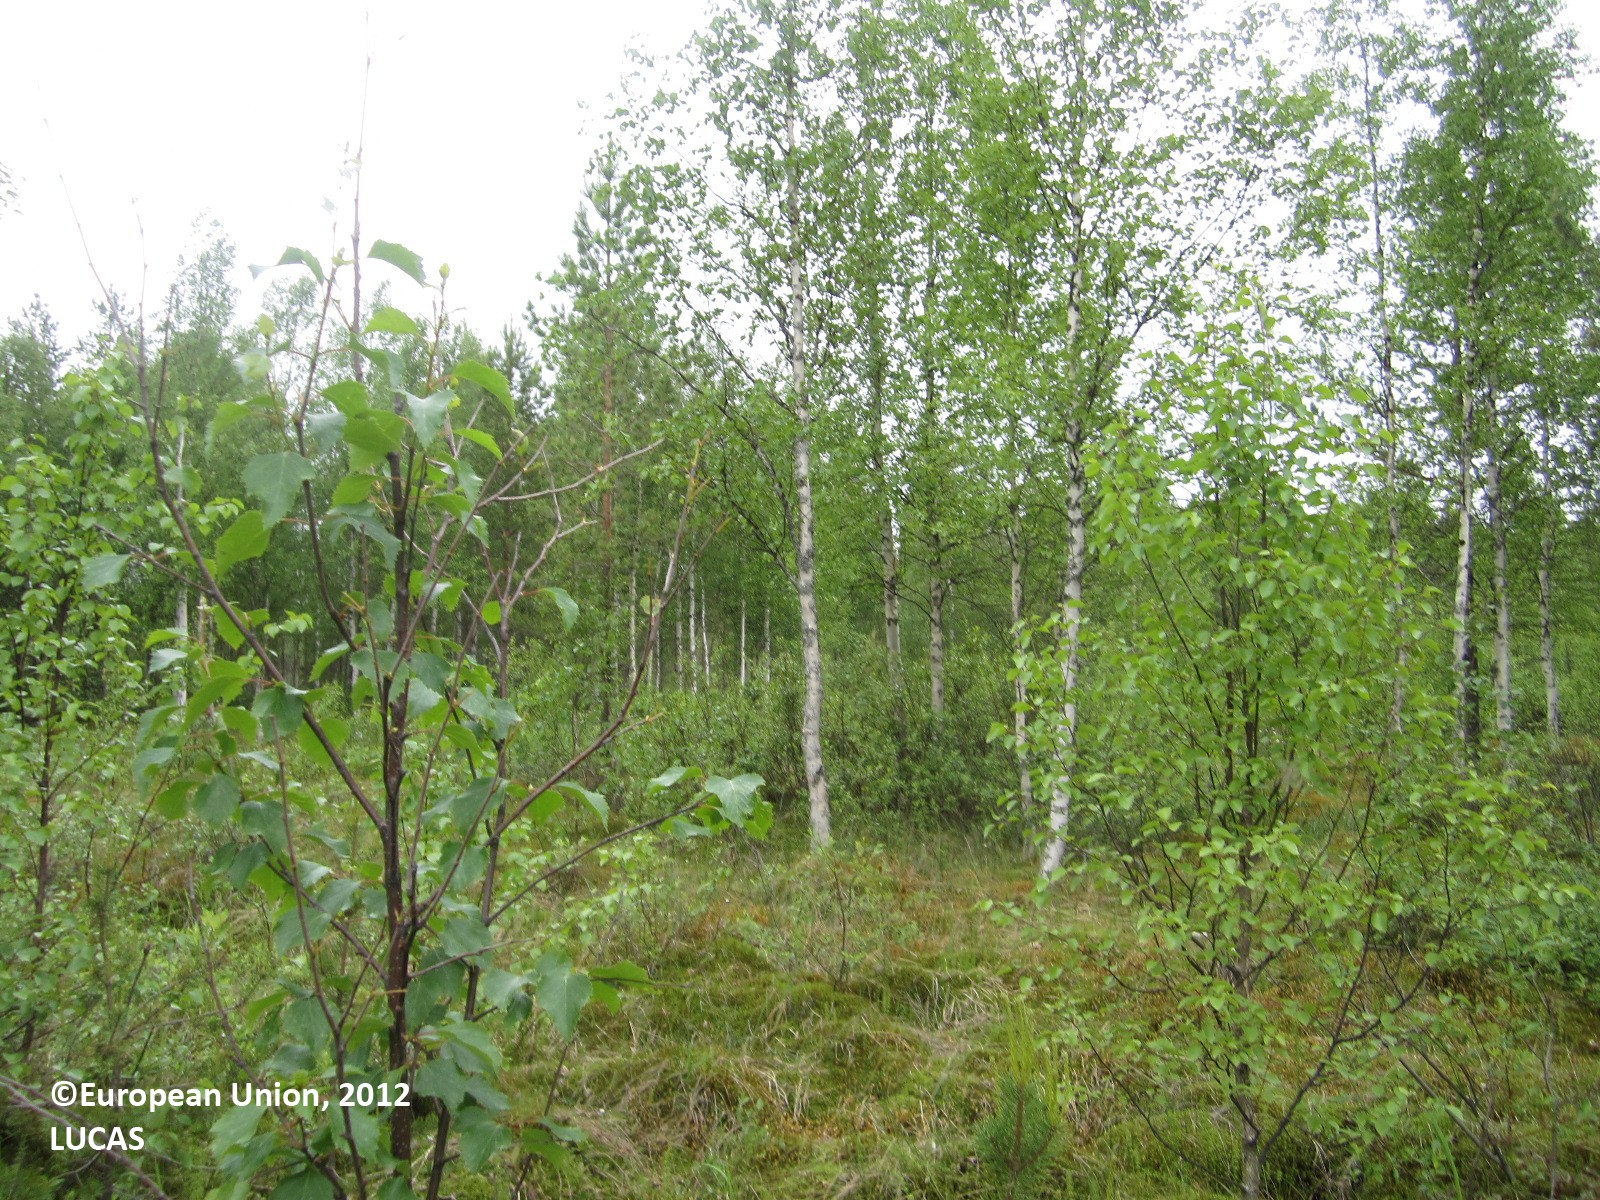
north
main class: Woodland
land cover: Broadleaved woodland
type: boreal forest
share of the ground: 50 - 75 %
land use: Forestry
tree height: > 5 m
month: June
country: FI
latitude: 64.7212
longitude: 29.6733
